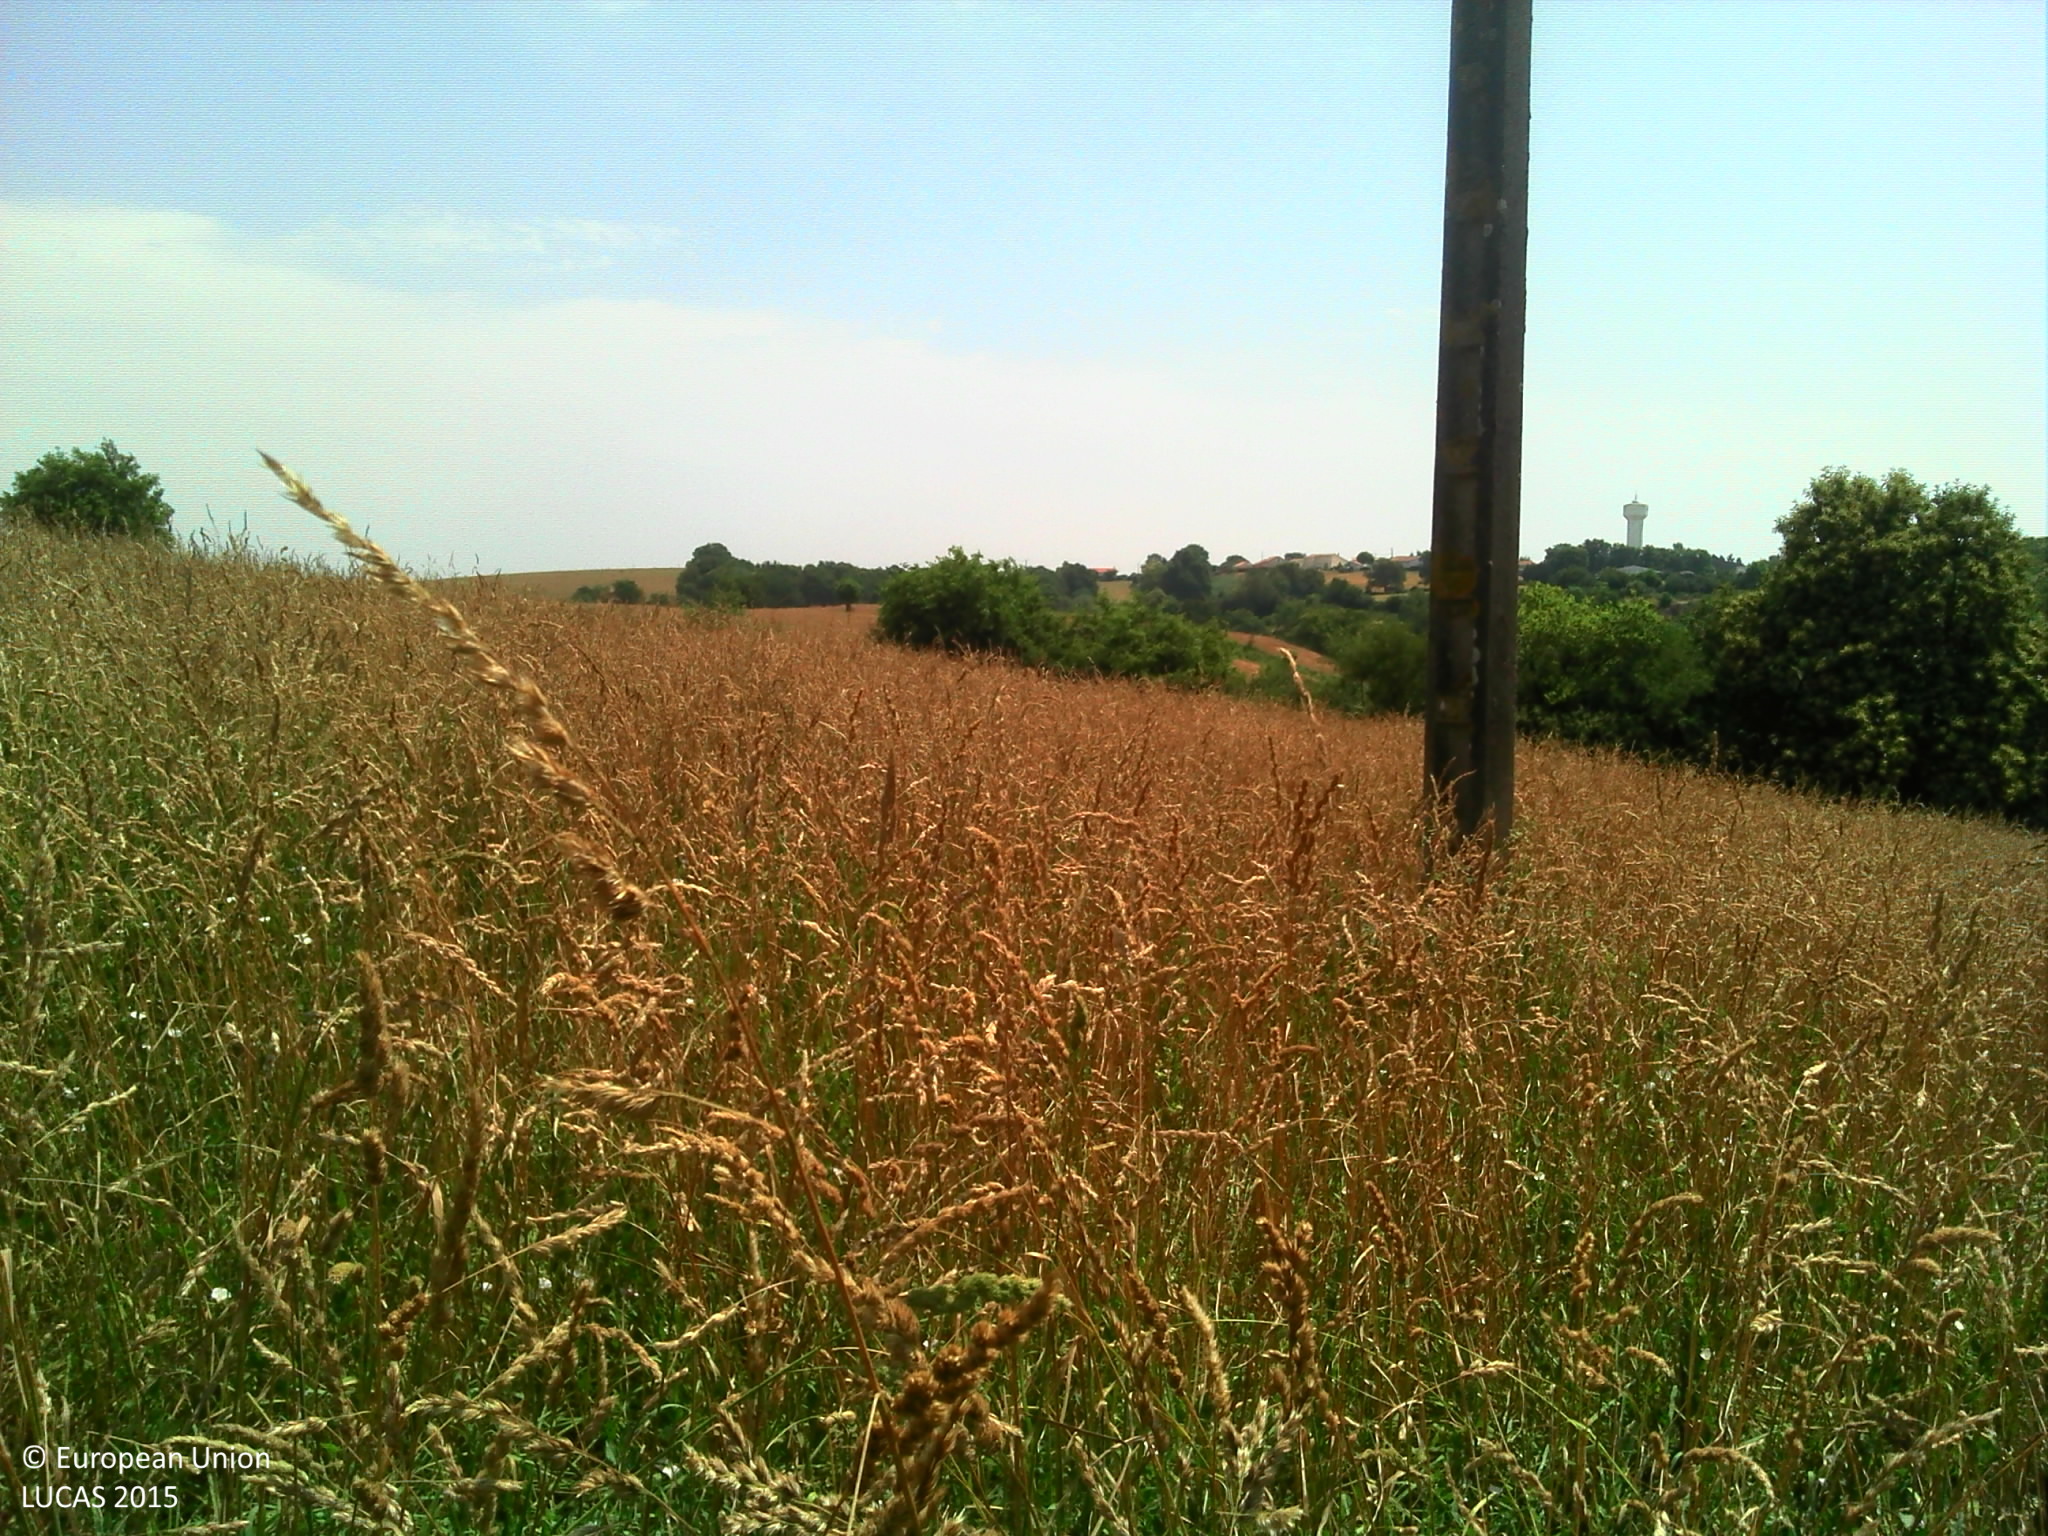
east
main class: Grassland
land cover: Grassland without tree/shrub cover
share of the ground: > 75 %
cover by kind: herbaceous plants 100 %
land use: Agriculture (excluding fallow land and kitchen gardens)
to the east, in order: Grassland without tree/shrub cover; Electric lines; Grassland without tree/shrub cover; Fences; Managed hedges; Ditches and canals; Grass margins; Paved roads, cycling and walking lanes; Grass margins; Ditches and canals; Fences; Grassland without tree/shrub cover; Fences; Grassland without tree/shrub cover; Fences; Grassland without tree/shrub cover
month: July
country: FR
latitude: 46.9728
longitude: -0.9036
